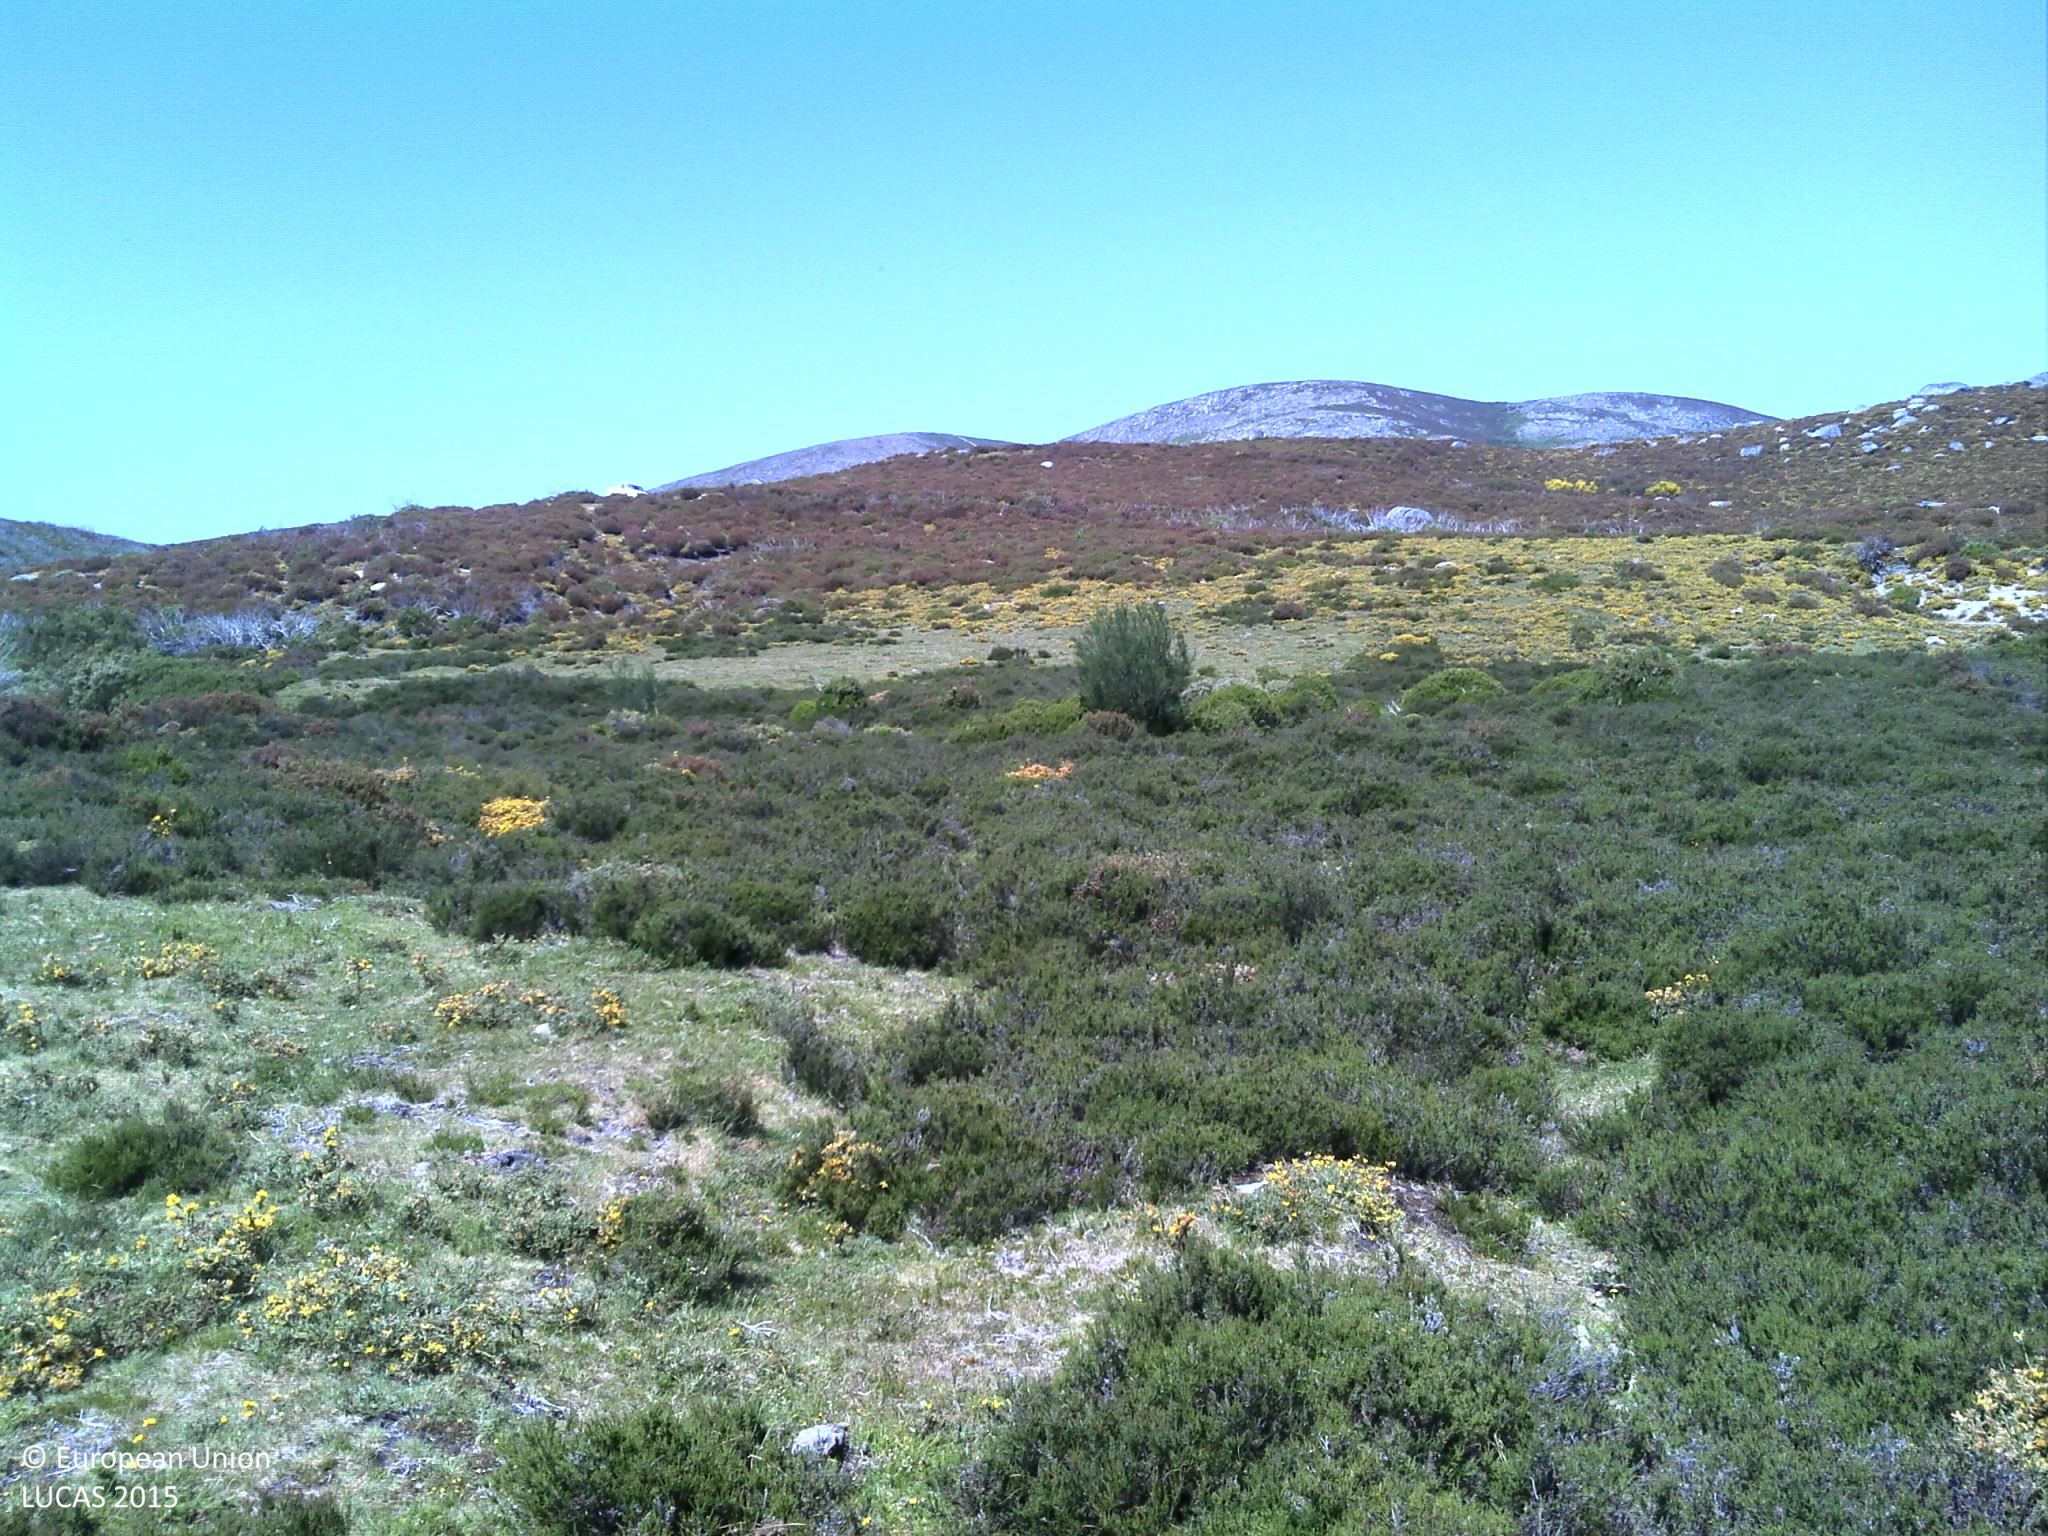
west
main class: Shrubland
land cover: Shrubland without tree cover
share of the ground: 50 - 75 %
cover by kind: shrubs 70 %, herbaceous plants 20 %, unconsolidated bare surface 10 %
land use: Agriculture (excluding fallow land and kitchen gardens)
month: June
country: PT
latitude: 41.9511
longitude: -8.2878
